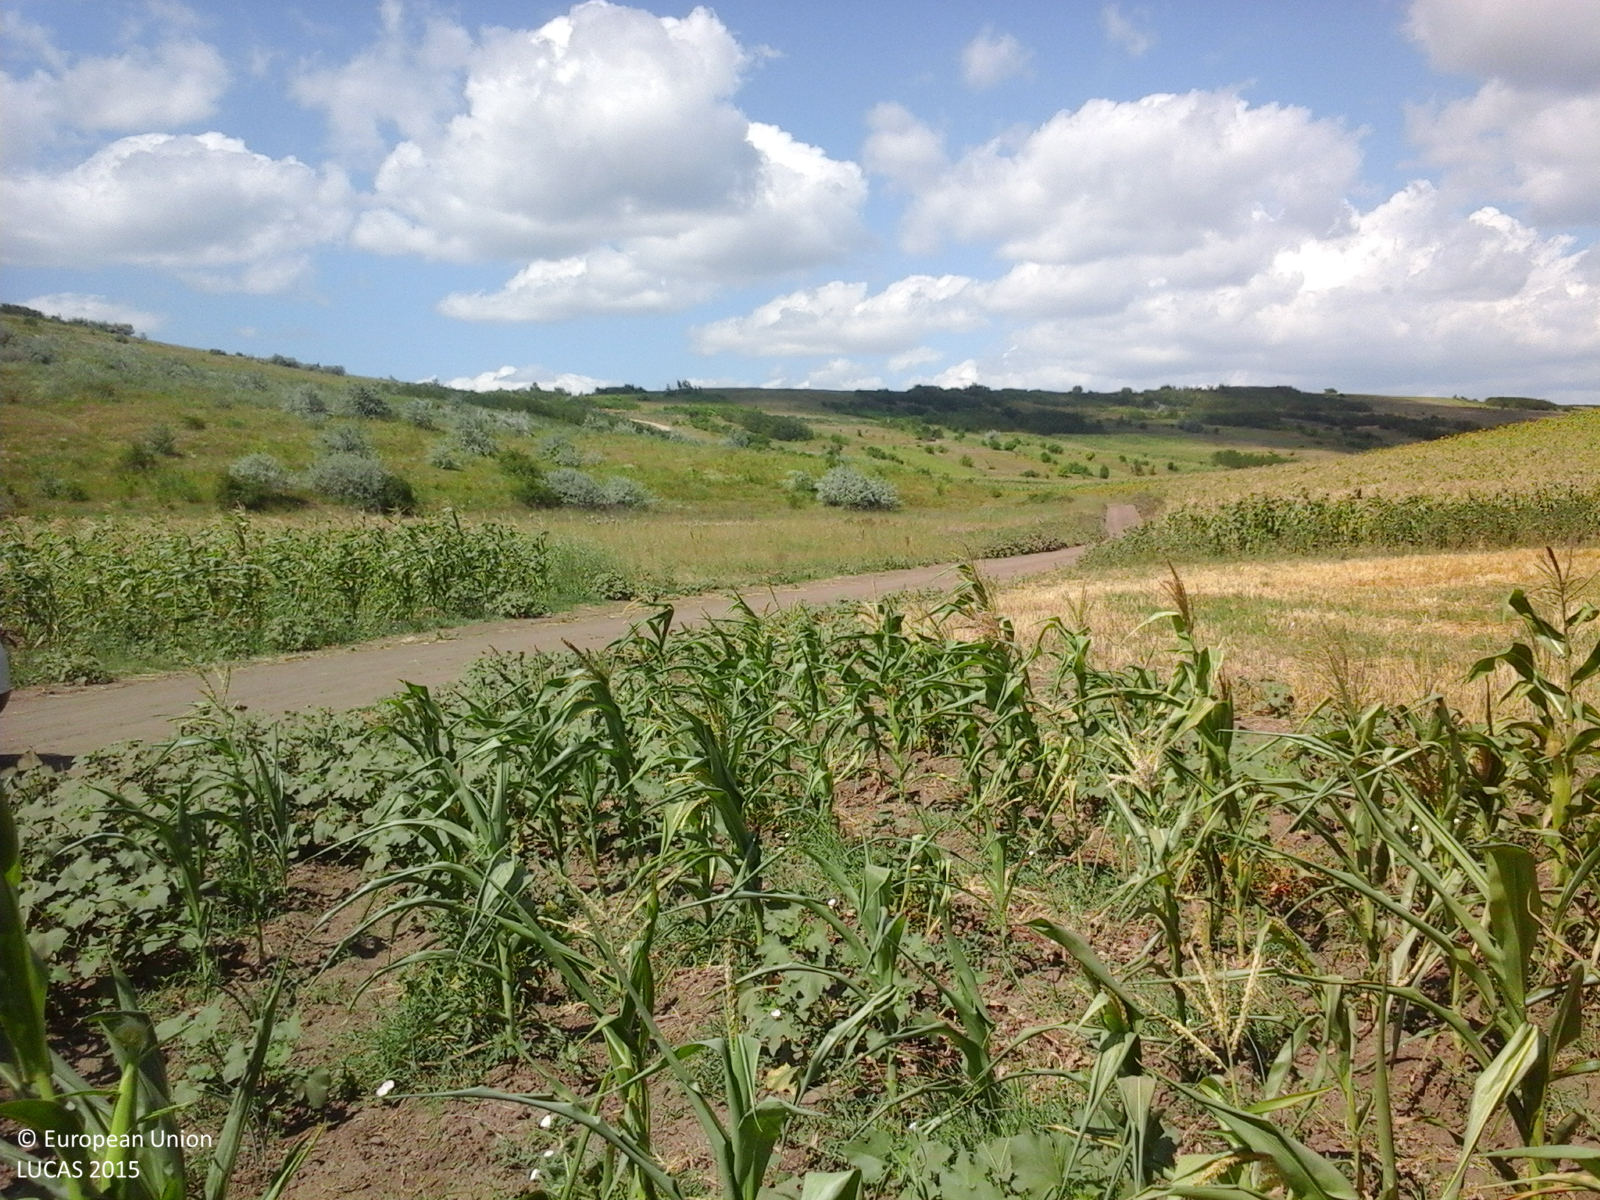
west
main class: Cropland
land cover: Maize
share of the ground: > 75 %
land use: Agriculture (excluding fallow land and kitchen gardens)
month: July
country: RO
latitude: 46.3529
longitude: 27.9129
